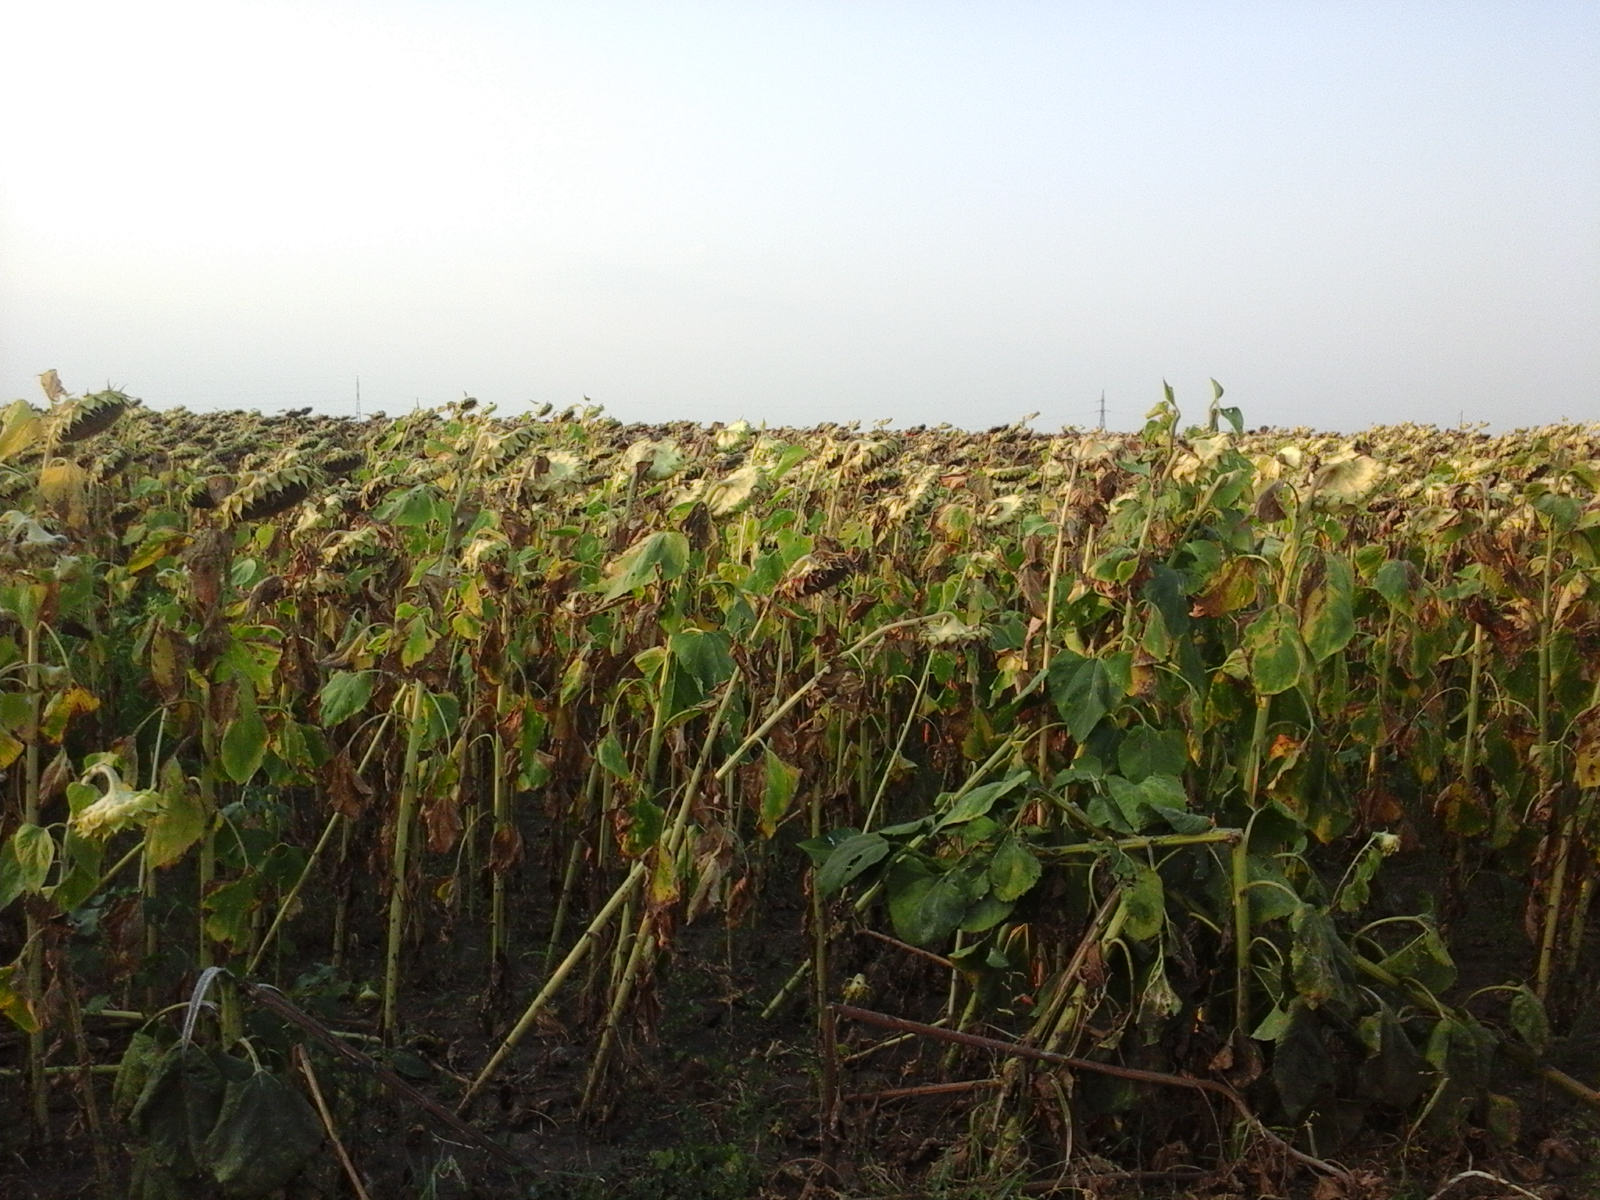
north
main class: Cropland
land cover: Sunflower
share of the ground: > 75 %
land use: Agriculture (excluding fallow land and kitchen gardens)
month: August
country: RO
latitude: 44.0428
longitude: 23.2619
